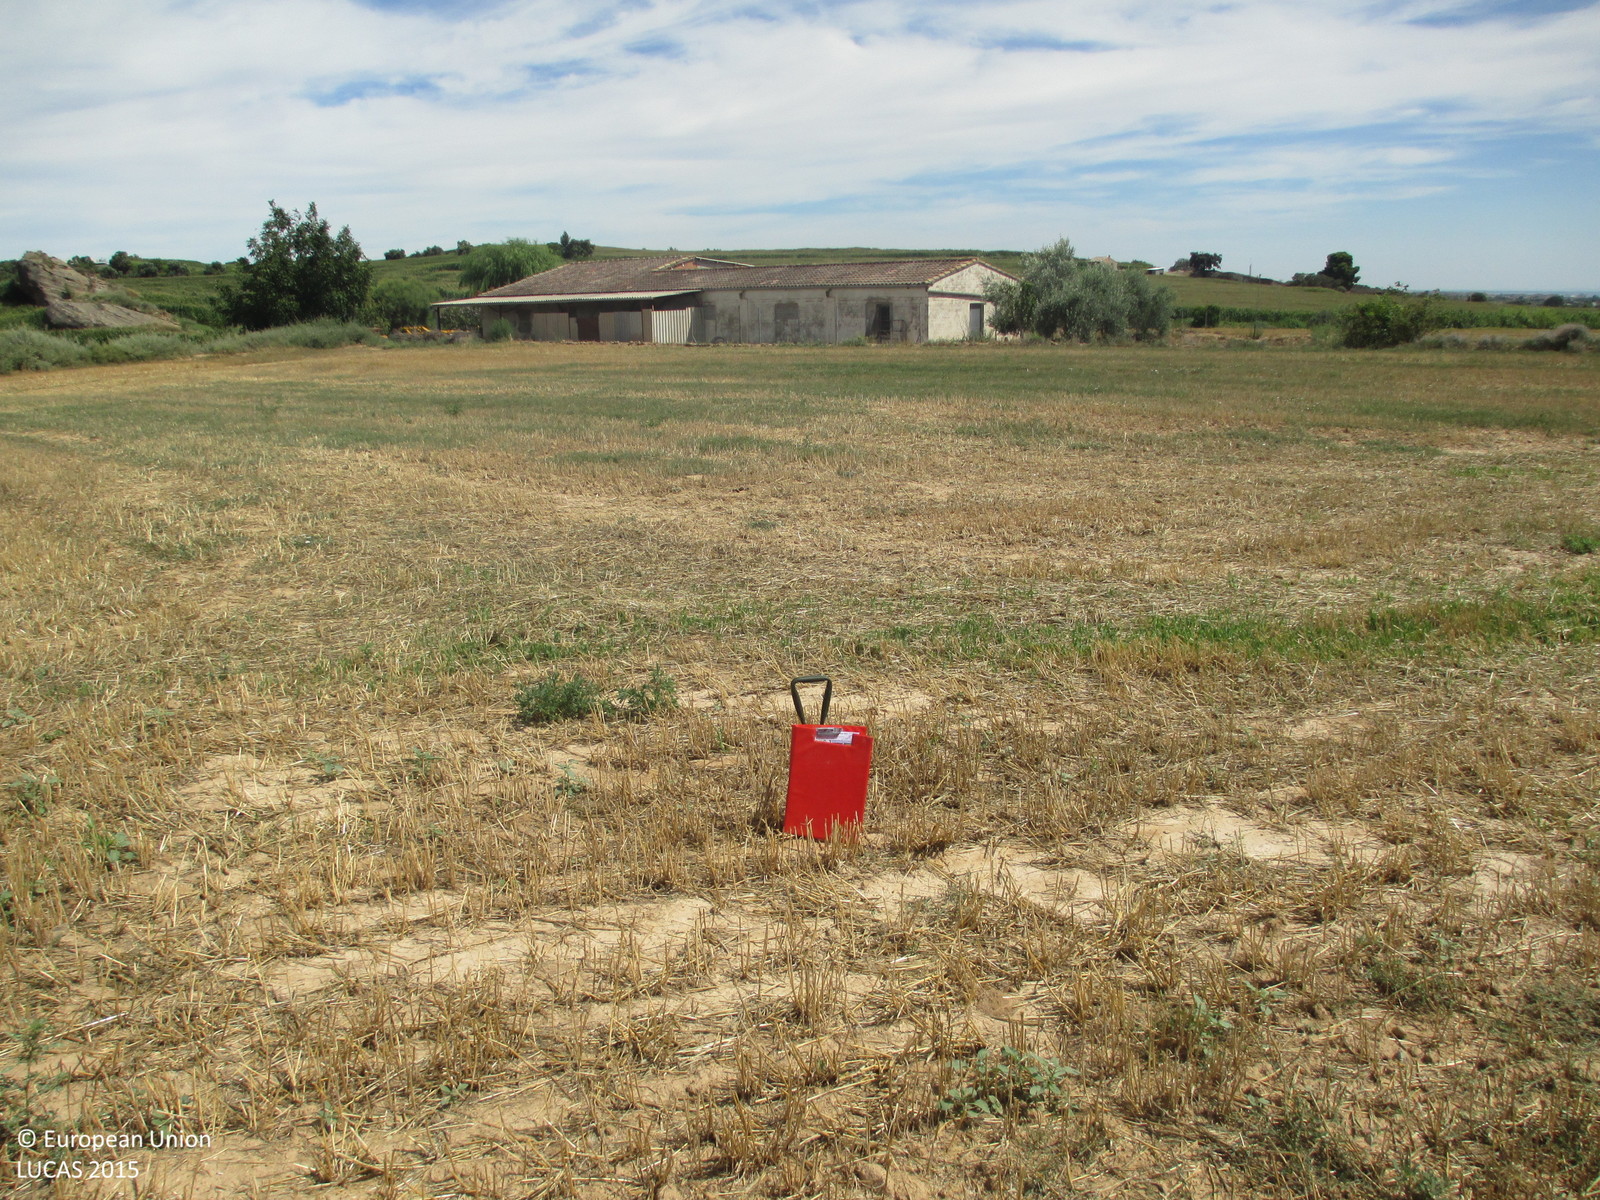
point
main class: Cropland
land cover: Barley
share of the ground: < 10 %
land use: Agriculture (excluding fallow land and kitchen gardens)
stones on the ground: < 10 %
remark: Harvested field
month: July
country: ES
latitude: 41.8970
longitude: 0.3050
